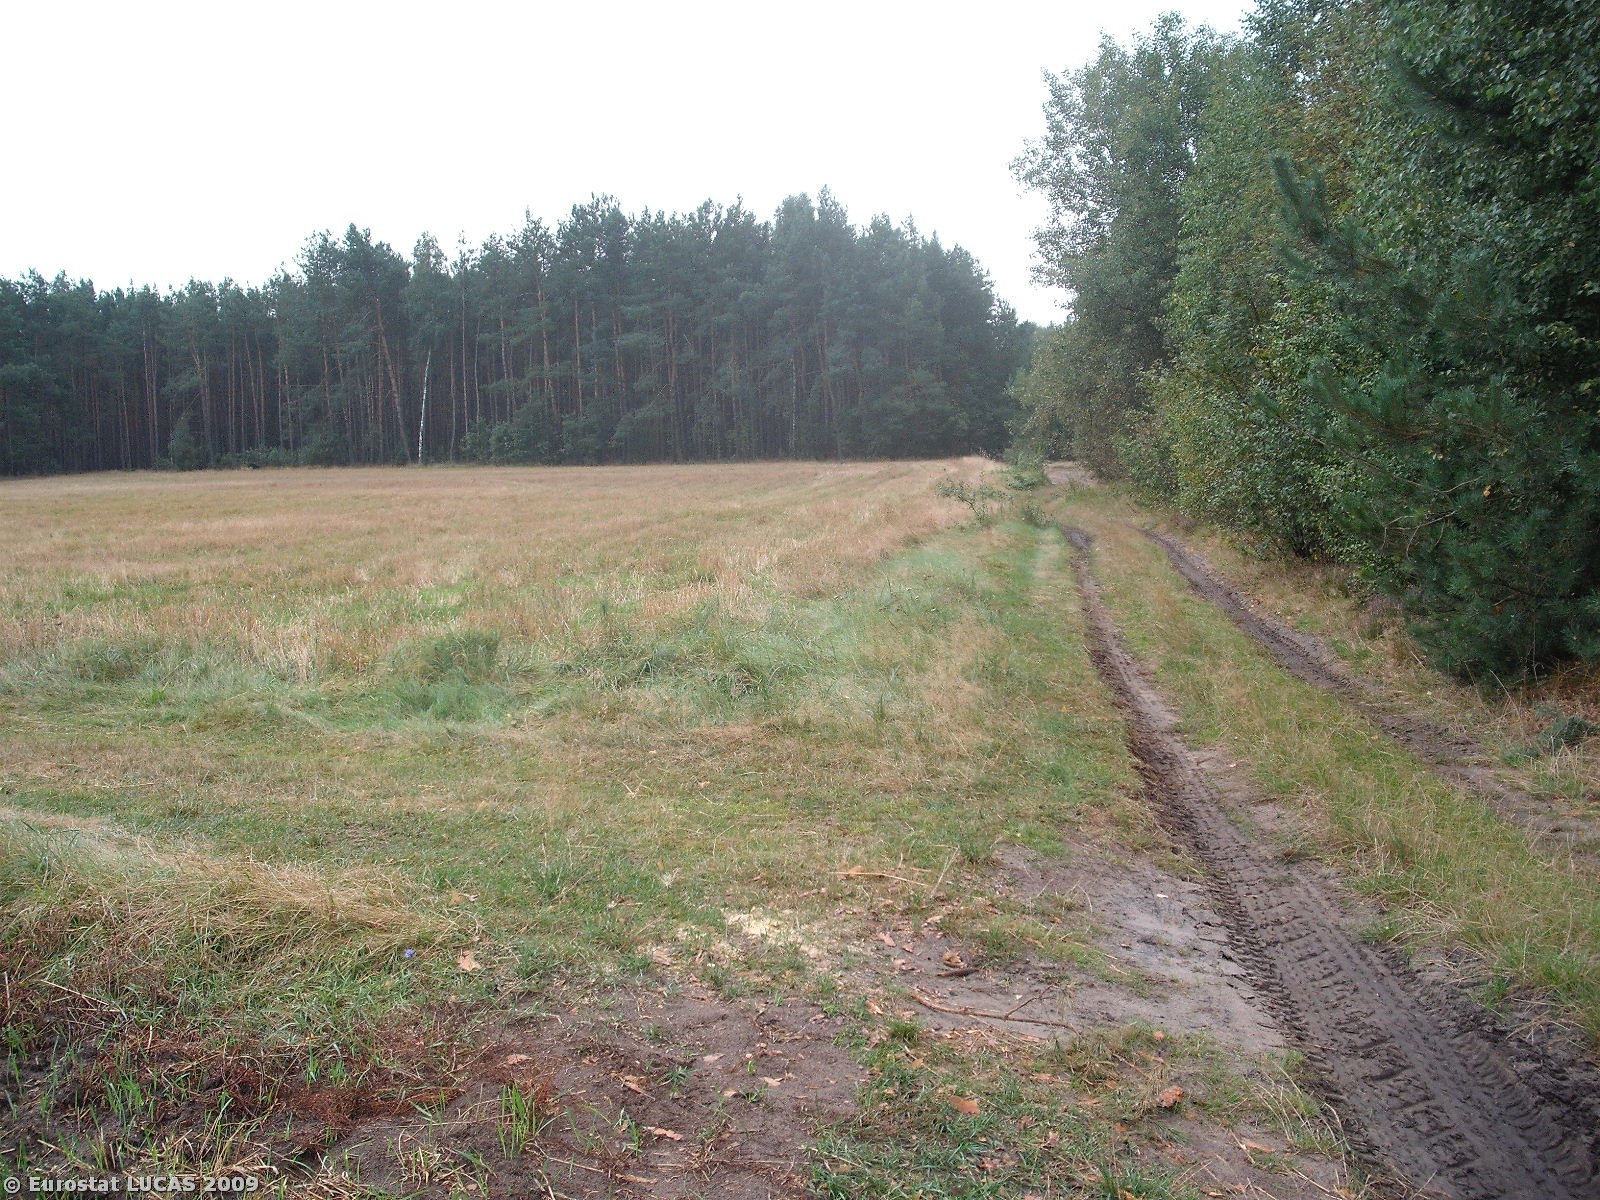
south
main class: Cropland
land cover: Mixed cereals for fodder
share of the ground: < 10 %
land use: Agriculture (excluding fallow land and kitchen gardens)
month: September
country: PL
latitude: 51.7235
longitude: 22.0605
